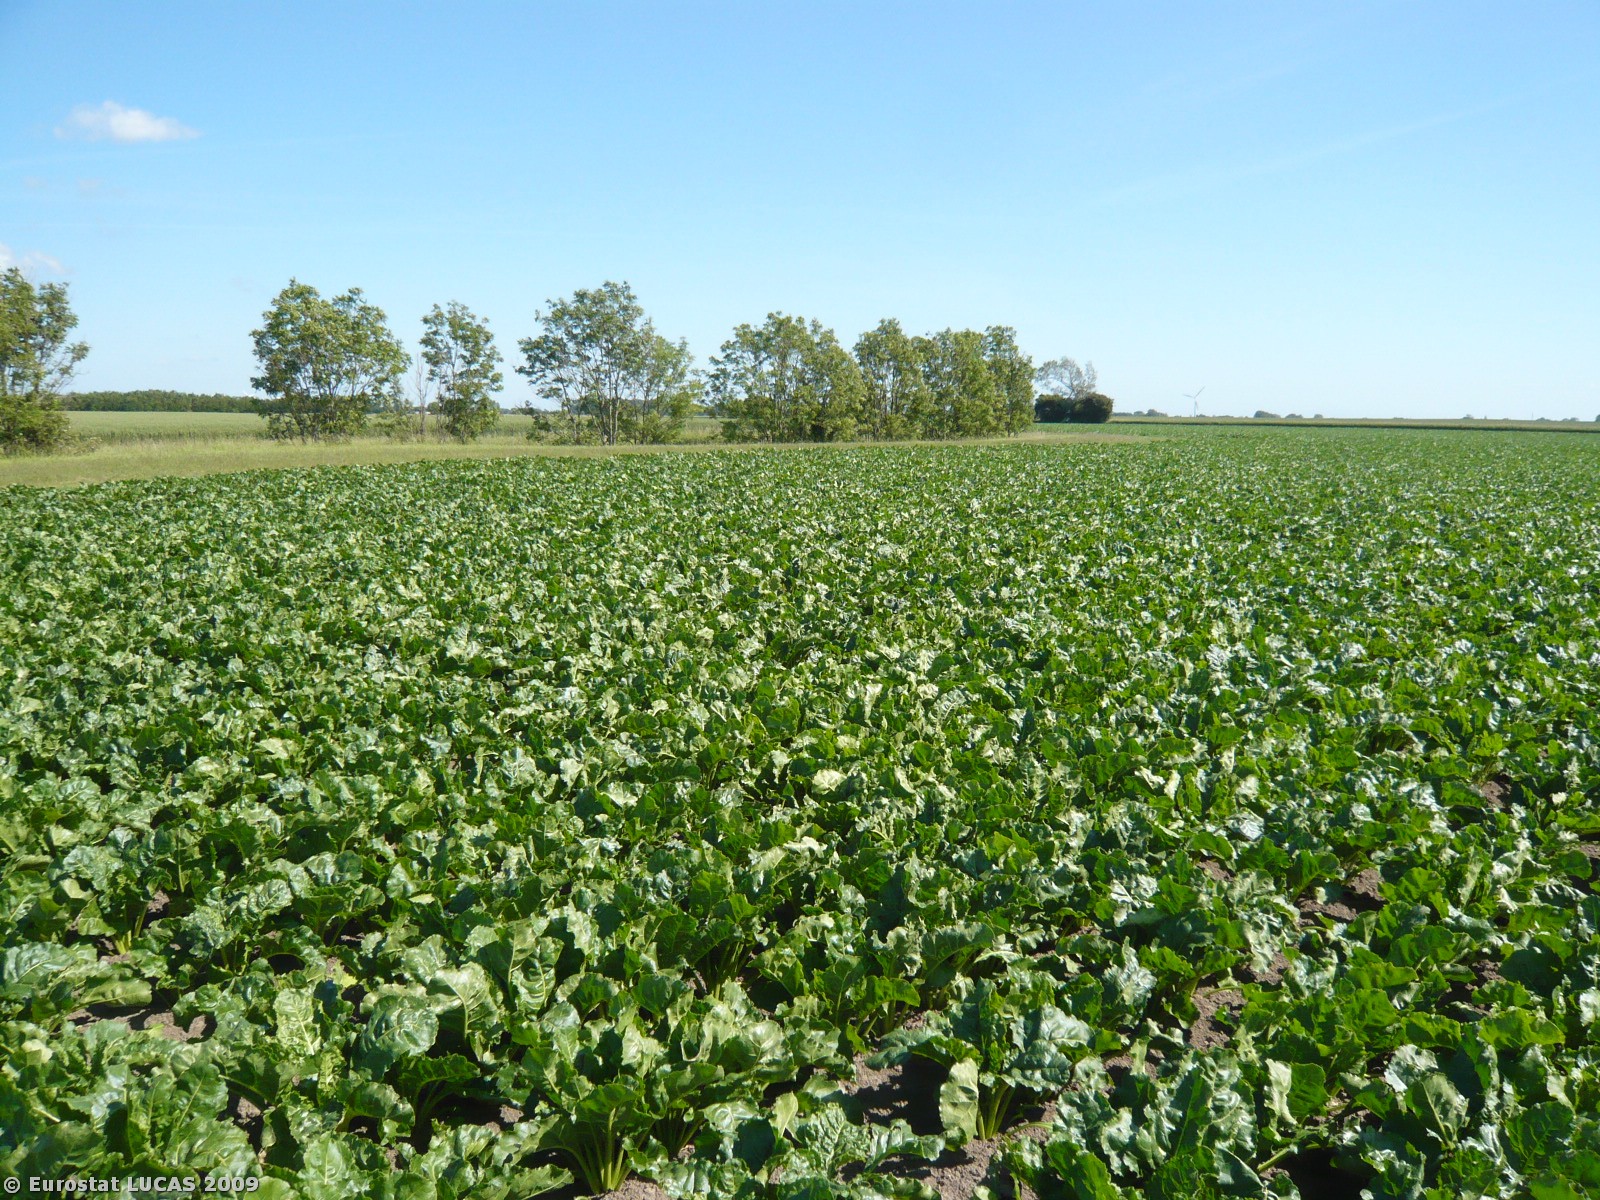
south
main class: Cropland
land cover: Sugar beet
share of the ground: > 75 %
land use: Agriculture (excluding fallow land and kitchen gardens)
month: June
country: DK
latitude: 54.7980
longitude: 11.1969
